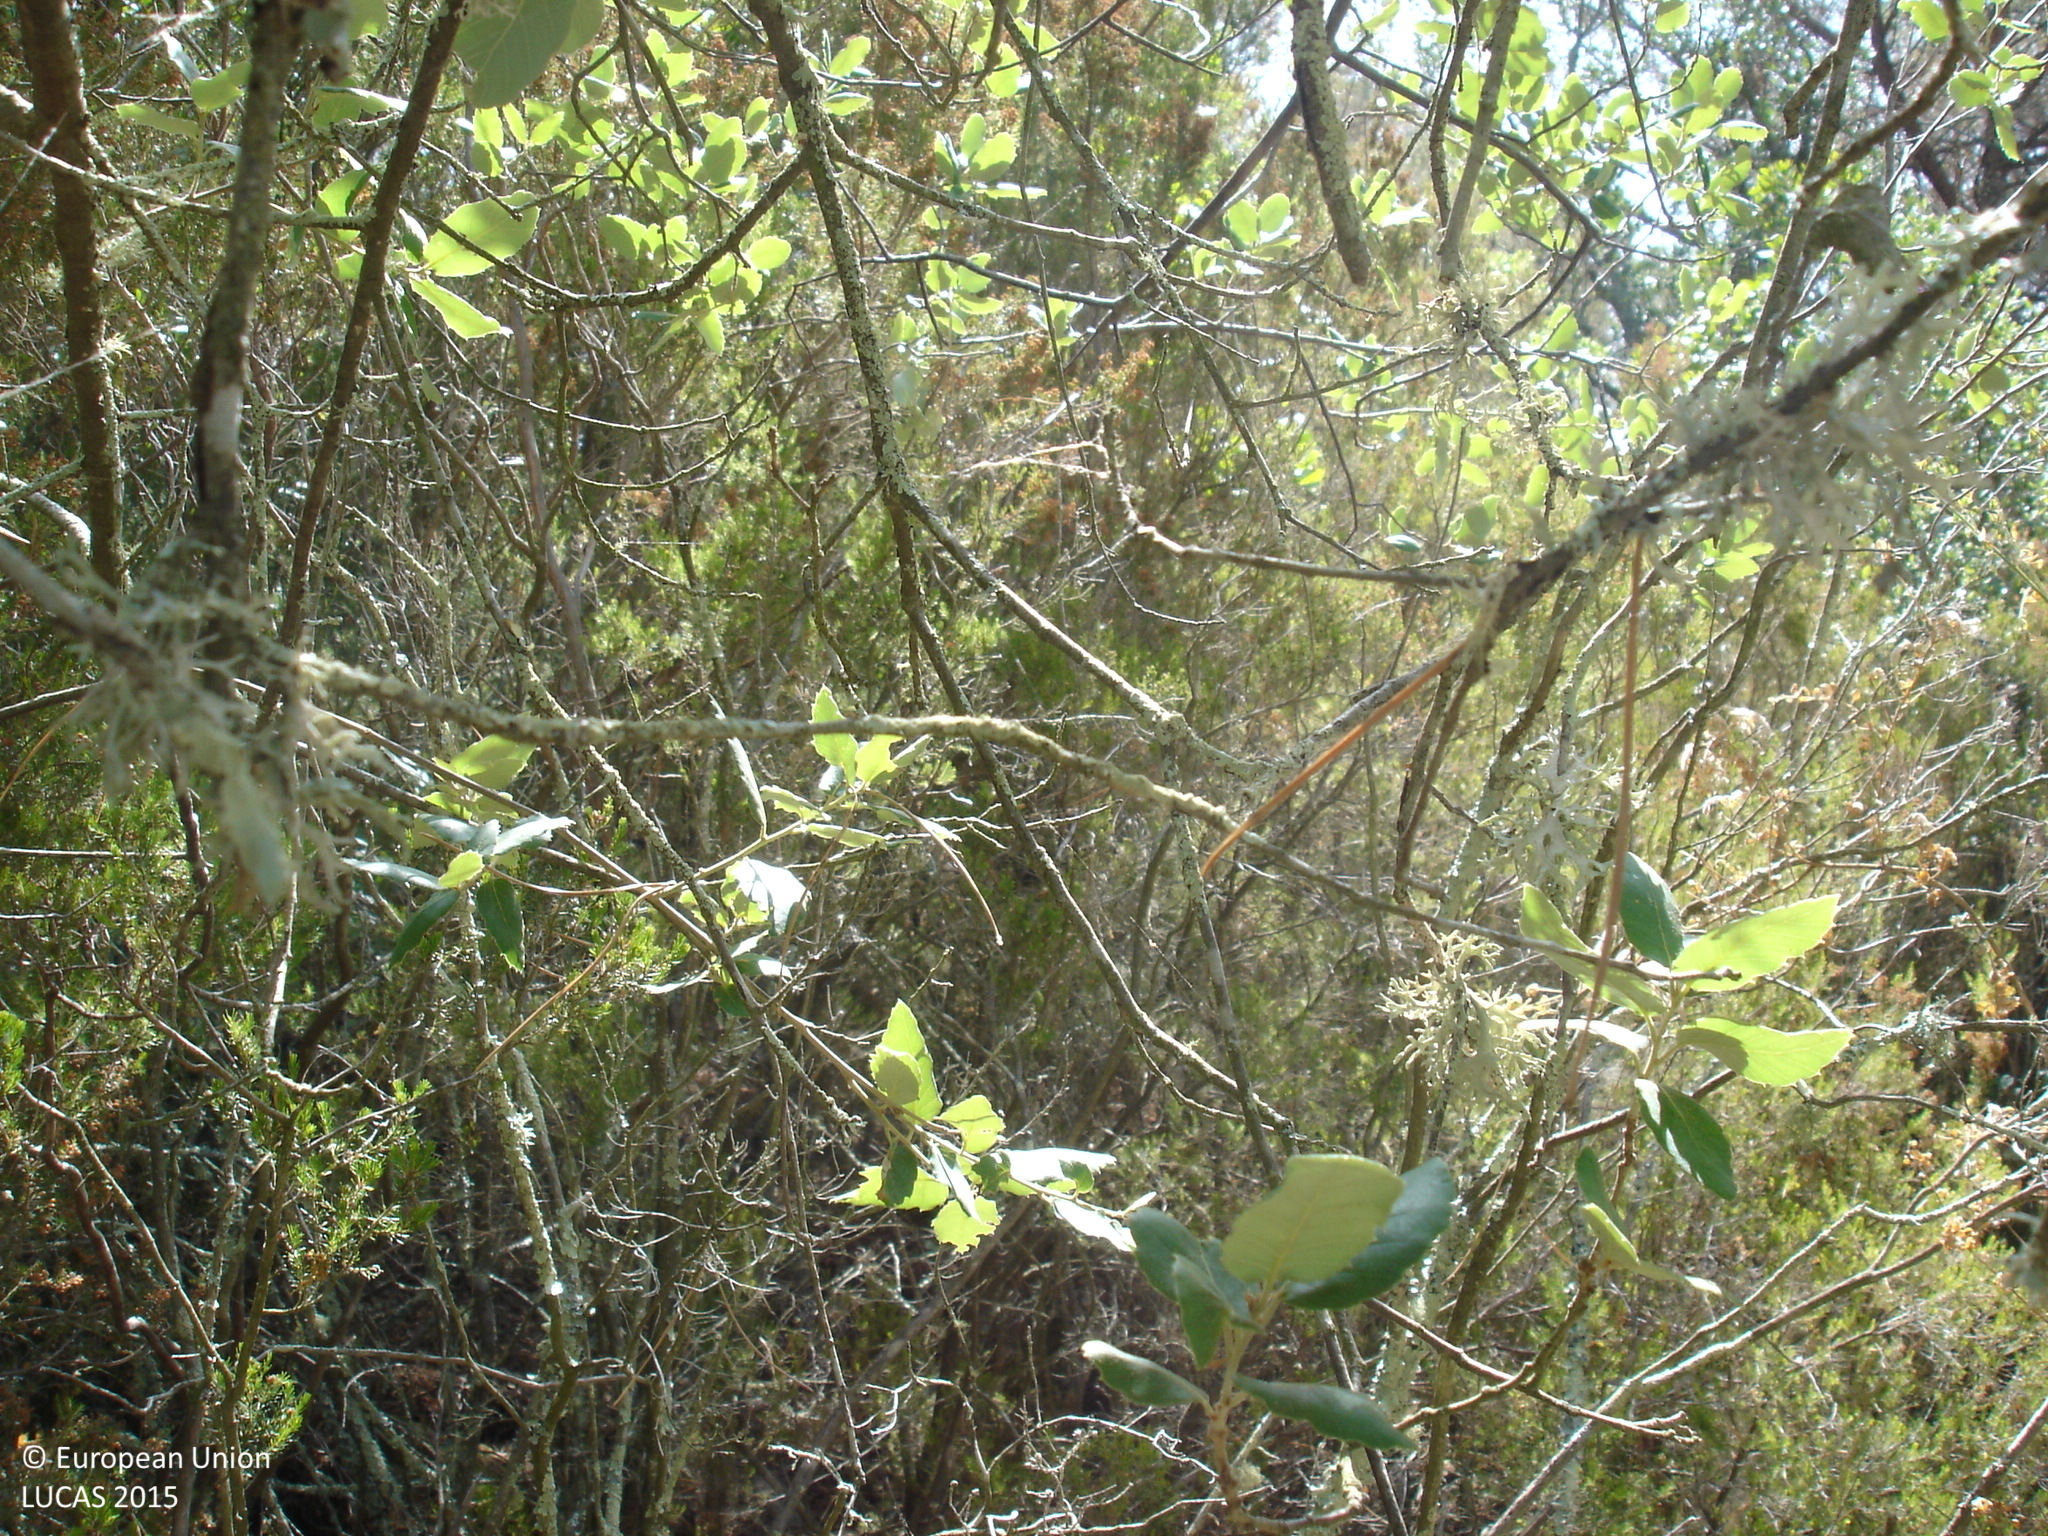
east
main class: Woodland
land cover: Other mixed woodland
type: thermophilous deciduous forest
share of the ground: > 75 %
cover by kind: broadleaved forest trees 70 %, coniferous forest trees 30 %
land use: Forestry
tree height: > 5 m
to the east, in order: Other mixed woodland; Tracks; Other mixed woodland; Pine dominated mixed woodland; Fences; Pine dominated mixed woodland; Fences; Grassland without tree/shrub cover; Pine dominated coniferous woodland; Artificial constructions in urban areas
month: July
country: ES
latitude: 41.8331
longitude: 3.0205
